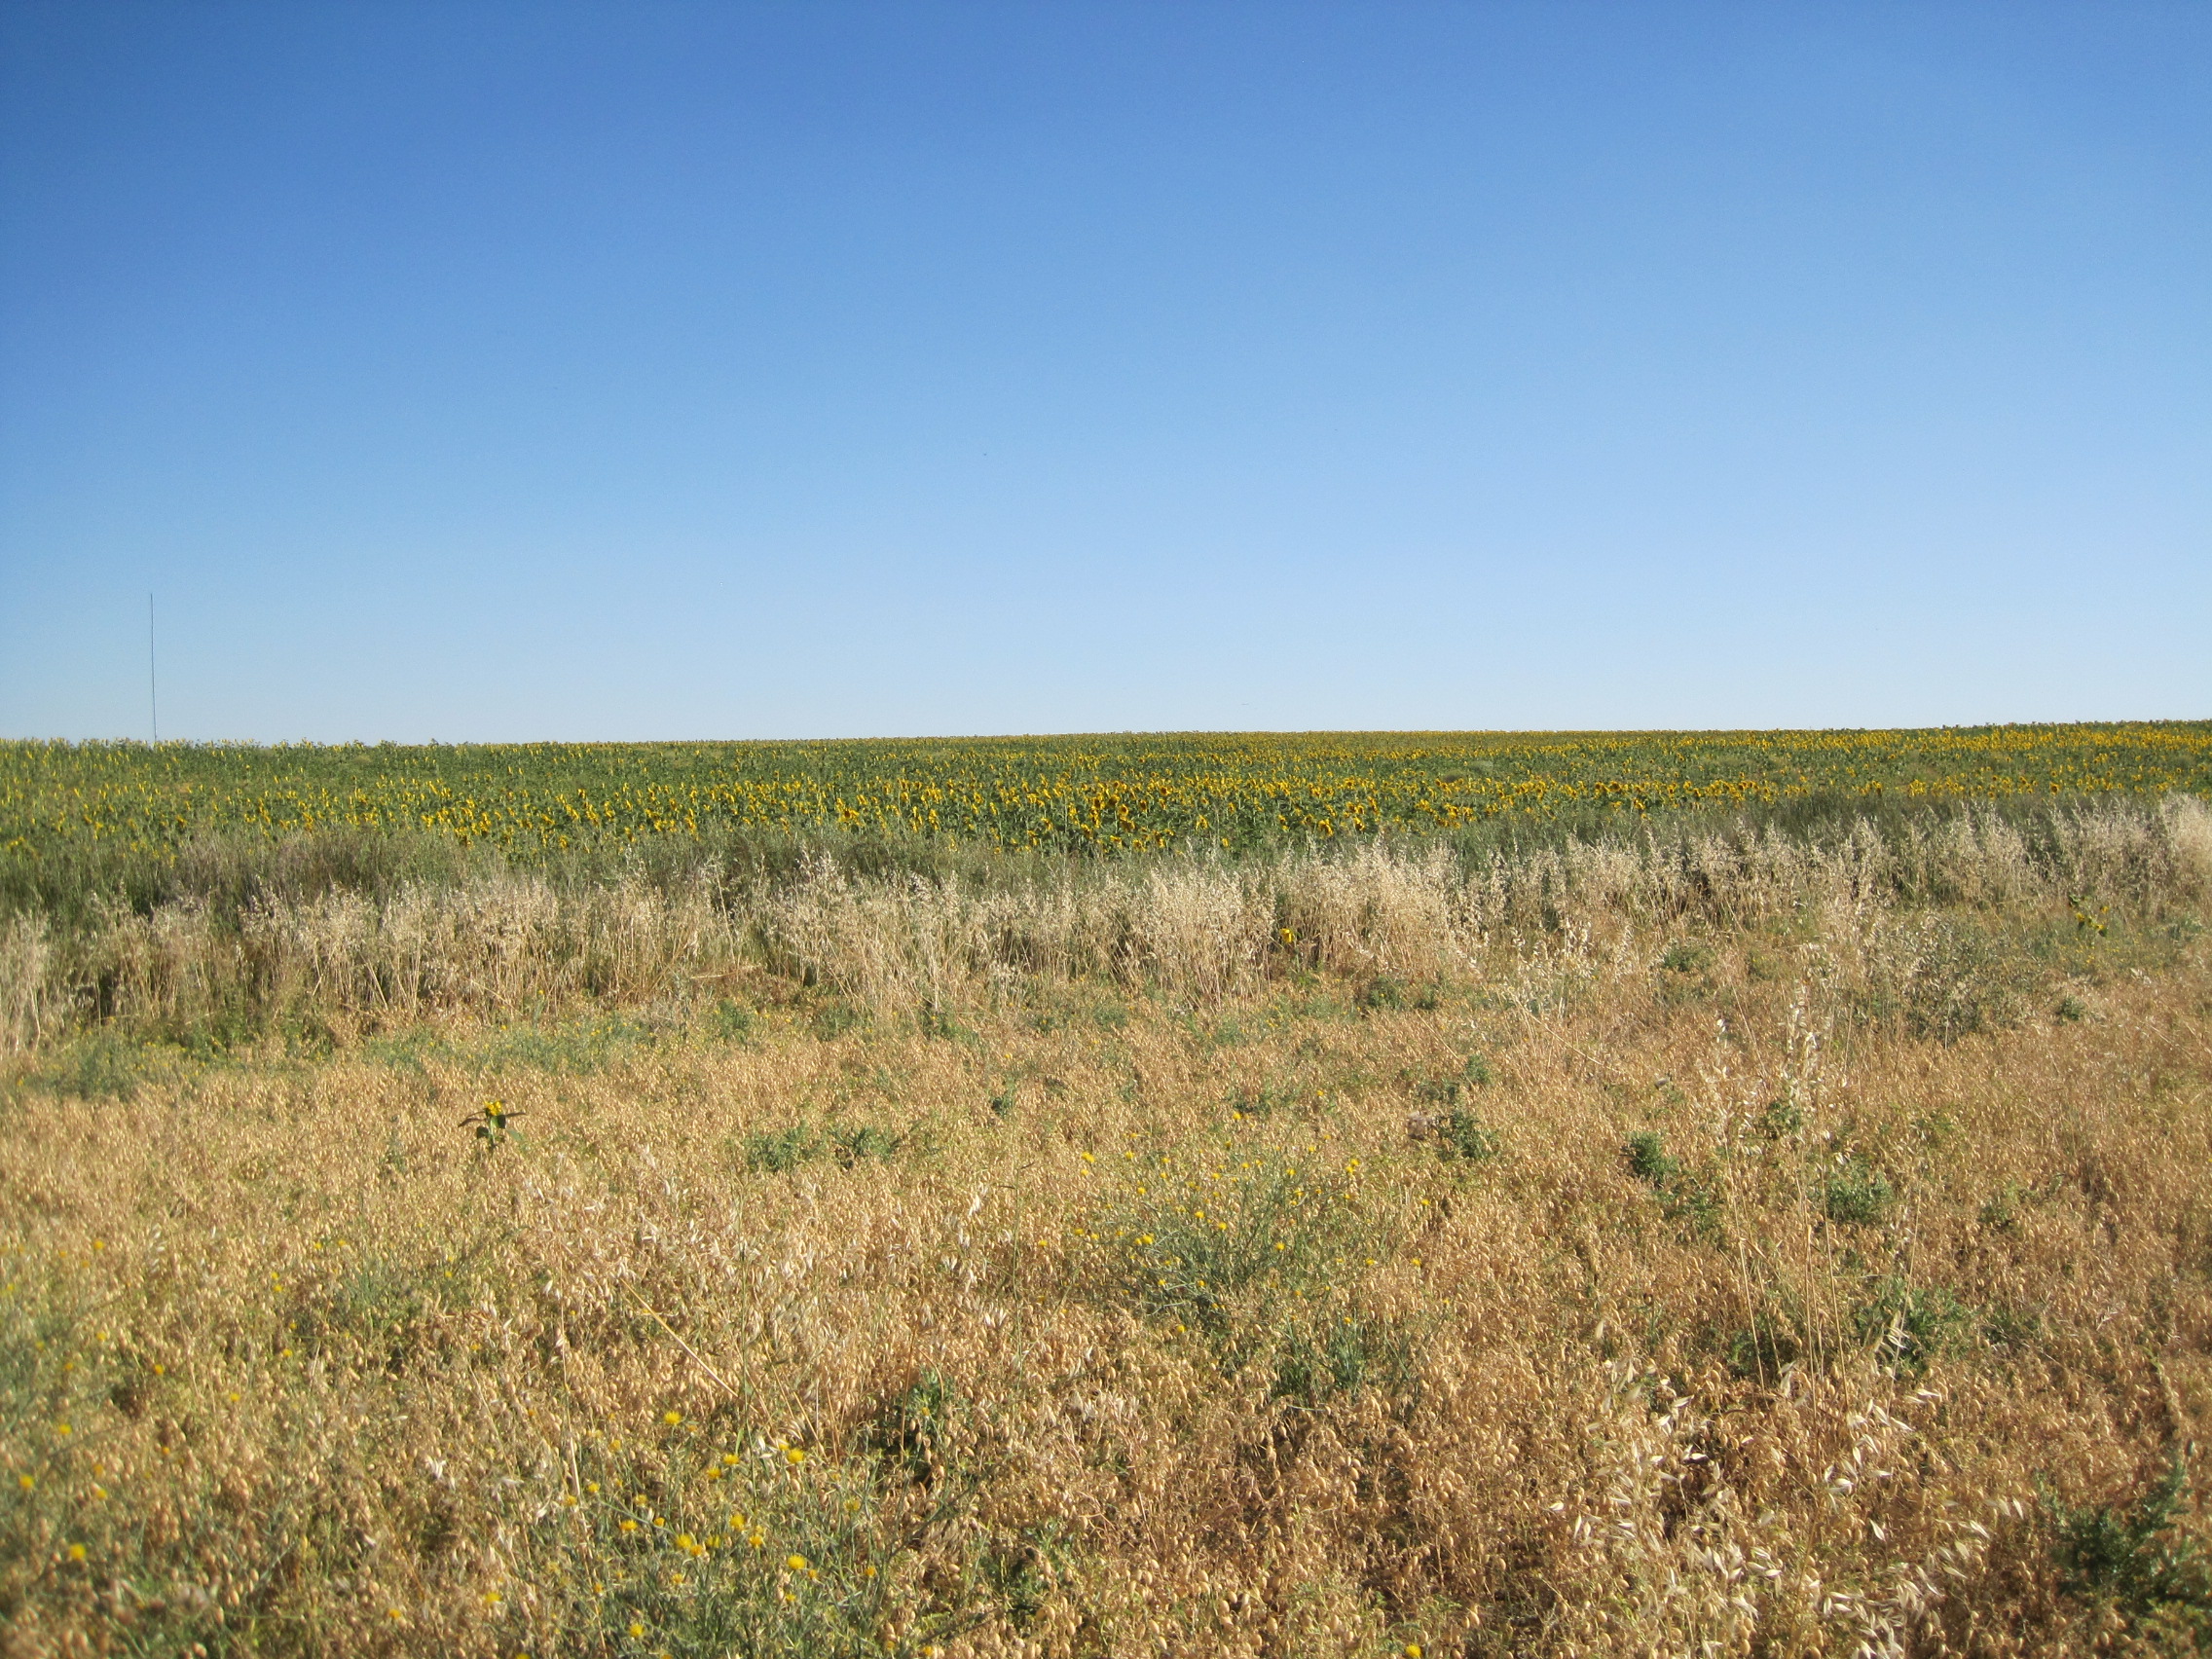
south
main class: Cropland
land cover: Dry pulses
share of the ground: > 75 %
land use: Agriculture (excluding fallow land and kitchen gardens)
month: July
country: ES
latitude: 42.1381
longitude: -5.2202
